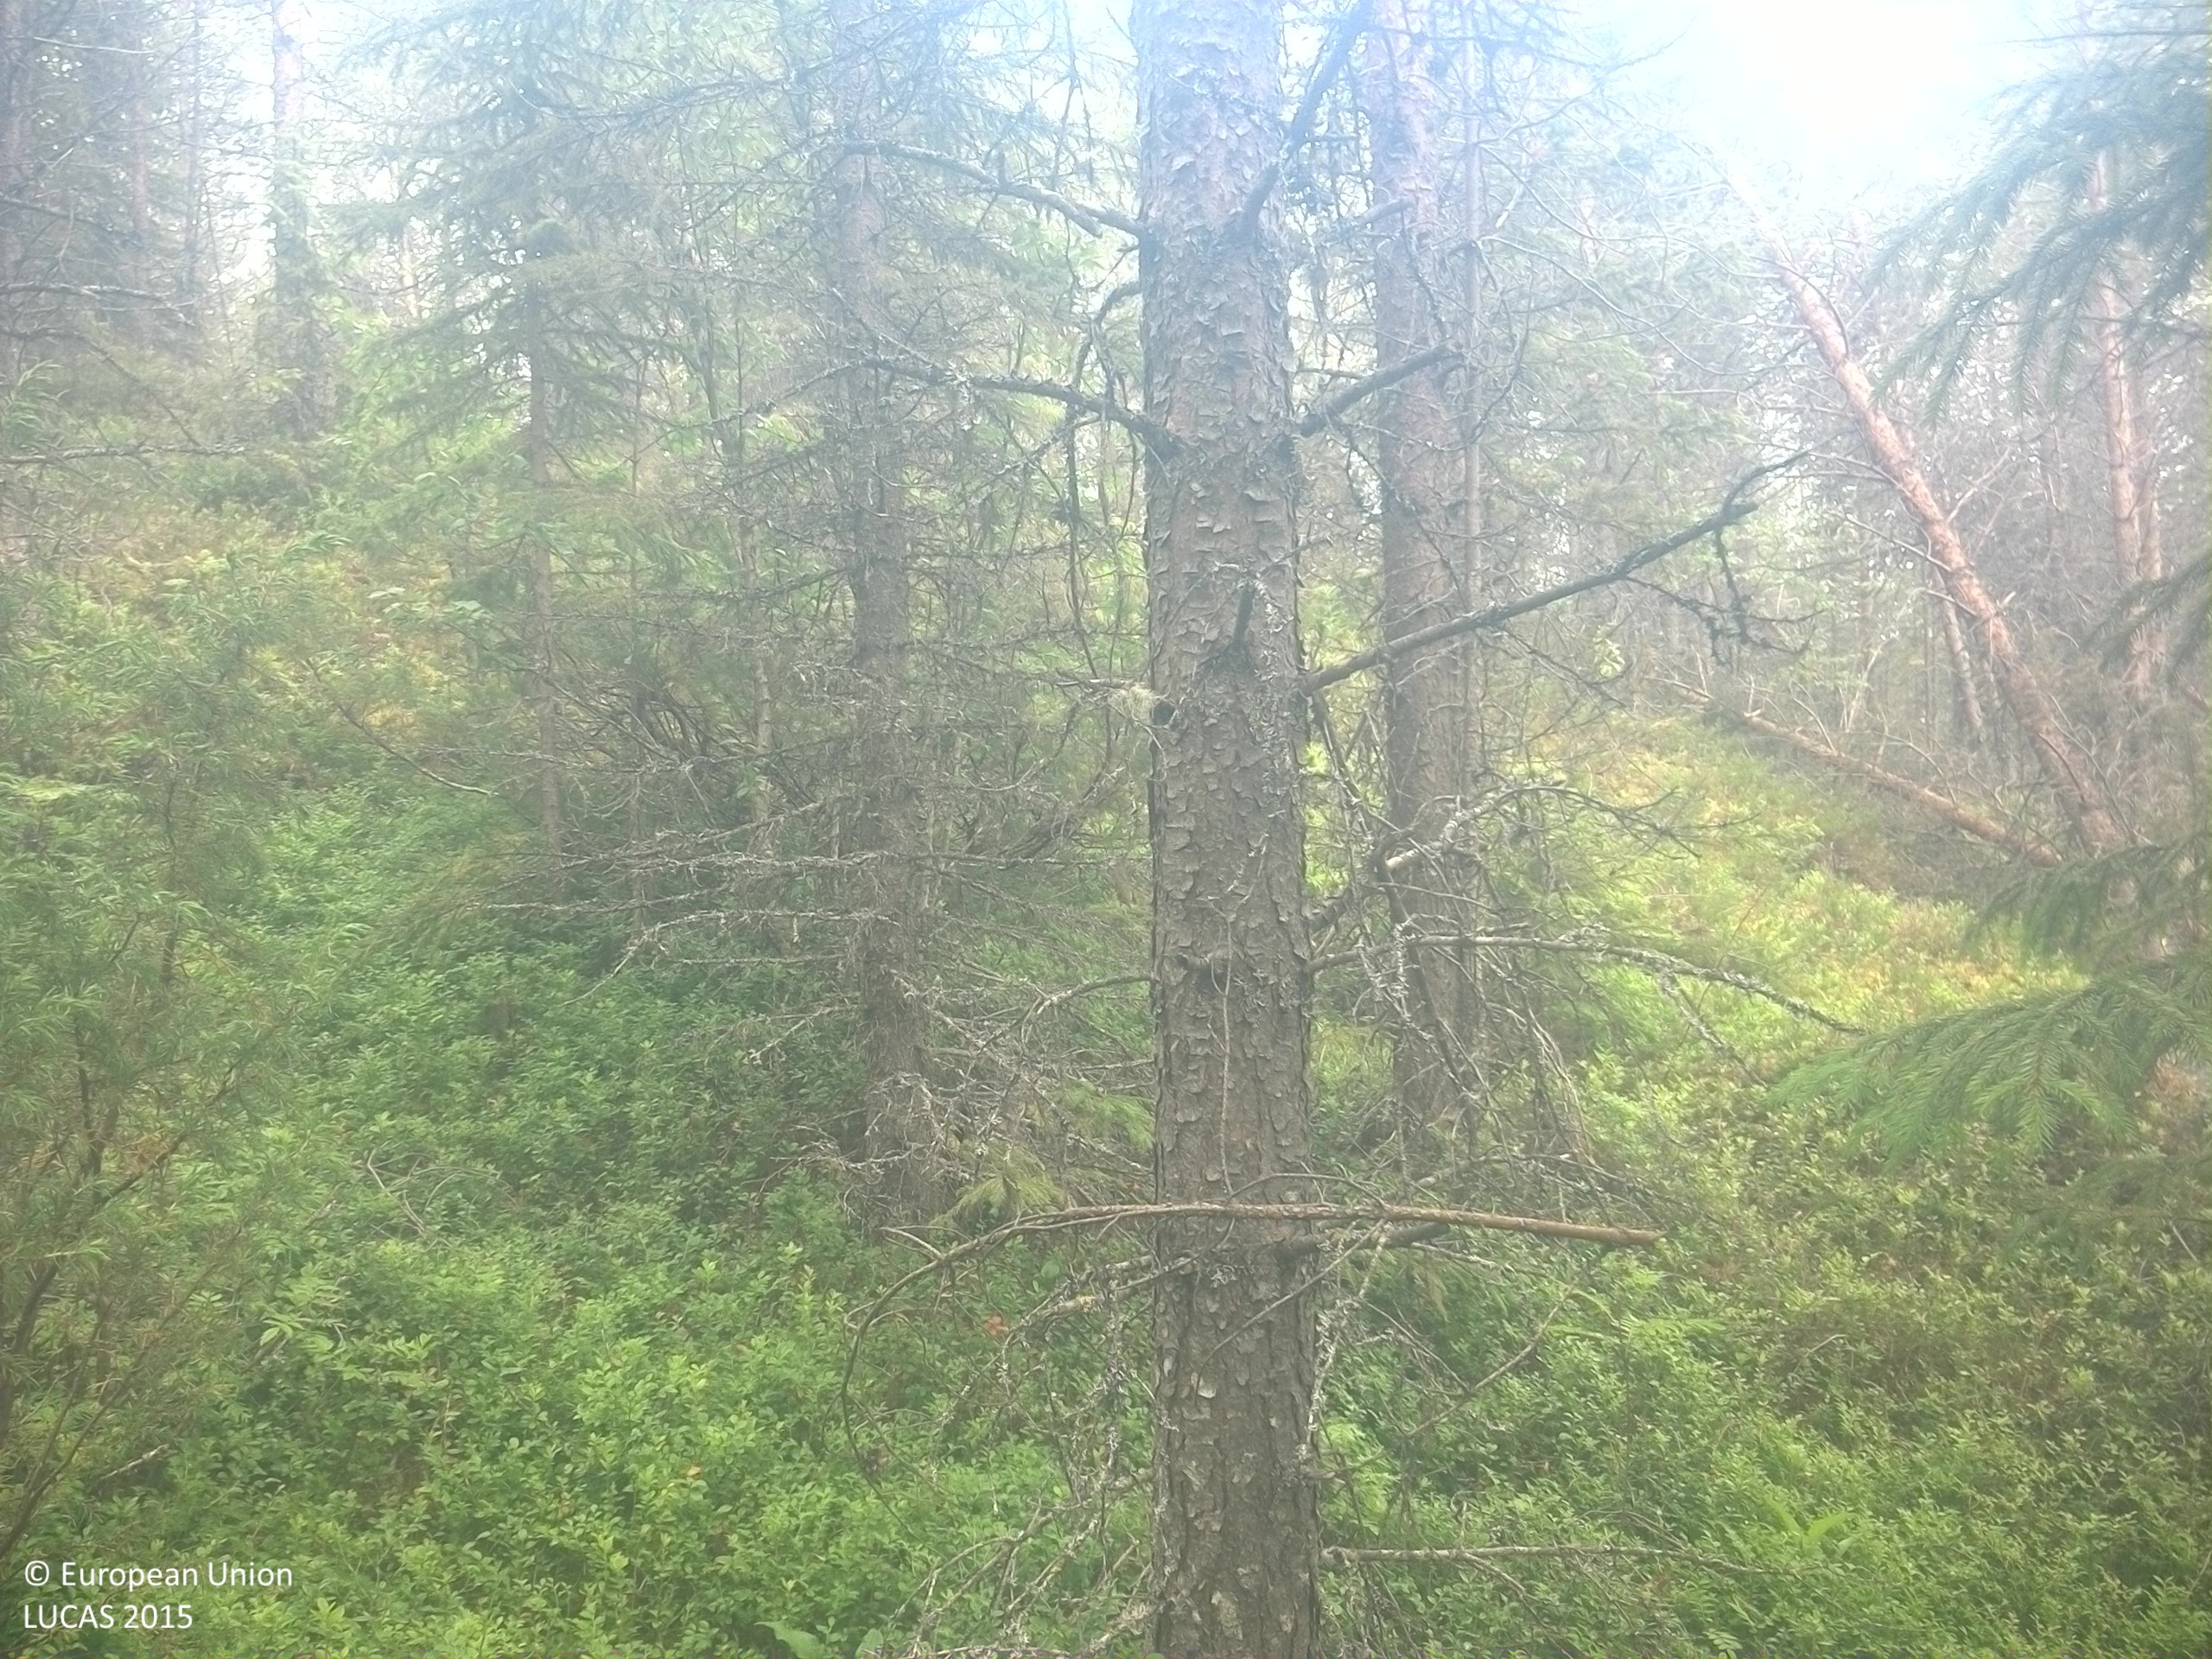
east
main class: Woodland
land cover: Pine dominated coniferous woodland
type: boreal forest
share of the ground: 50 - 75 %
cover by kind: coniferous forest trees 50 %, shrubs 30 %, lichens and mosses 10 %, broadleaved forest trees 5 %, consolidated bare surface 5 %
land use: Forestry
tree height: > 5 m
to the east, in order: Pine dominated coniferous woodland; Tracks; Pine dominated coniferous woodland; Pine dominated mixed woodland; Tracks; Spruce dominated coniferous woodland; Shrubland with sparse tree cover
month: July
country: SE
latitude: 64.1824
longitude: 16.7404
